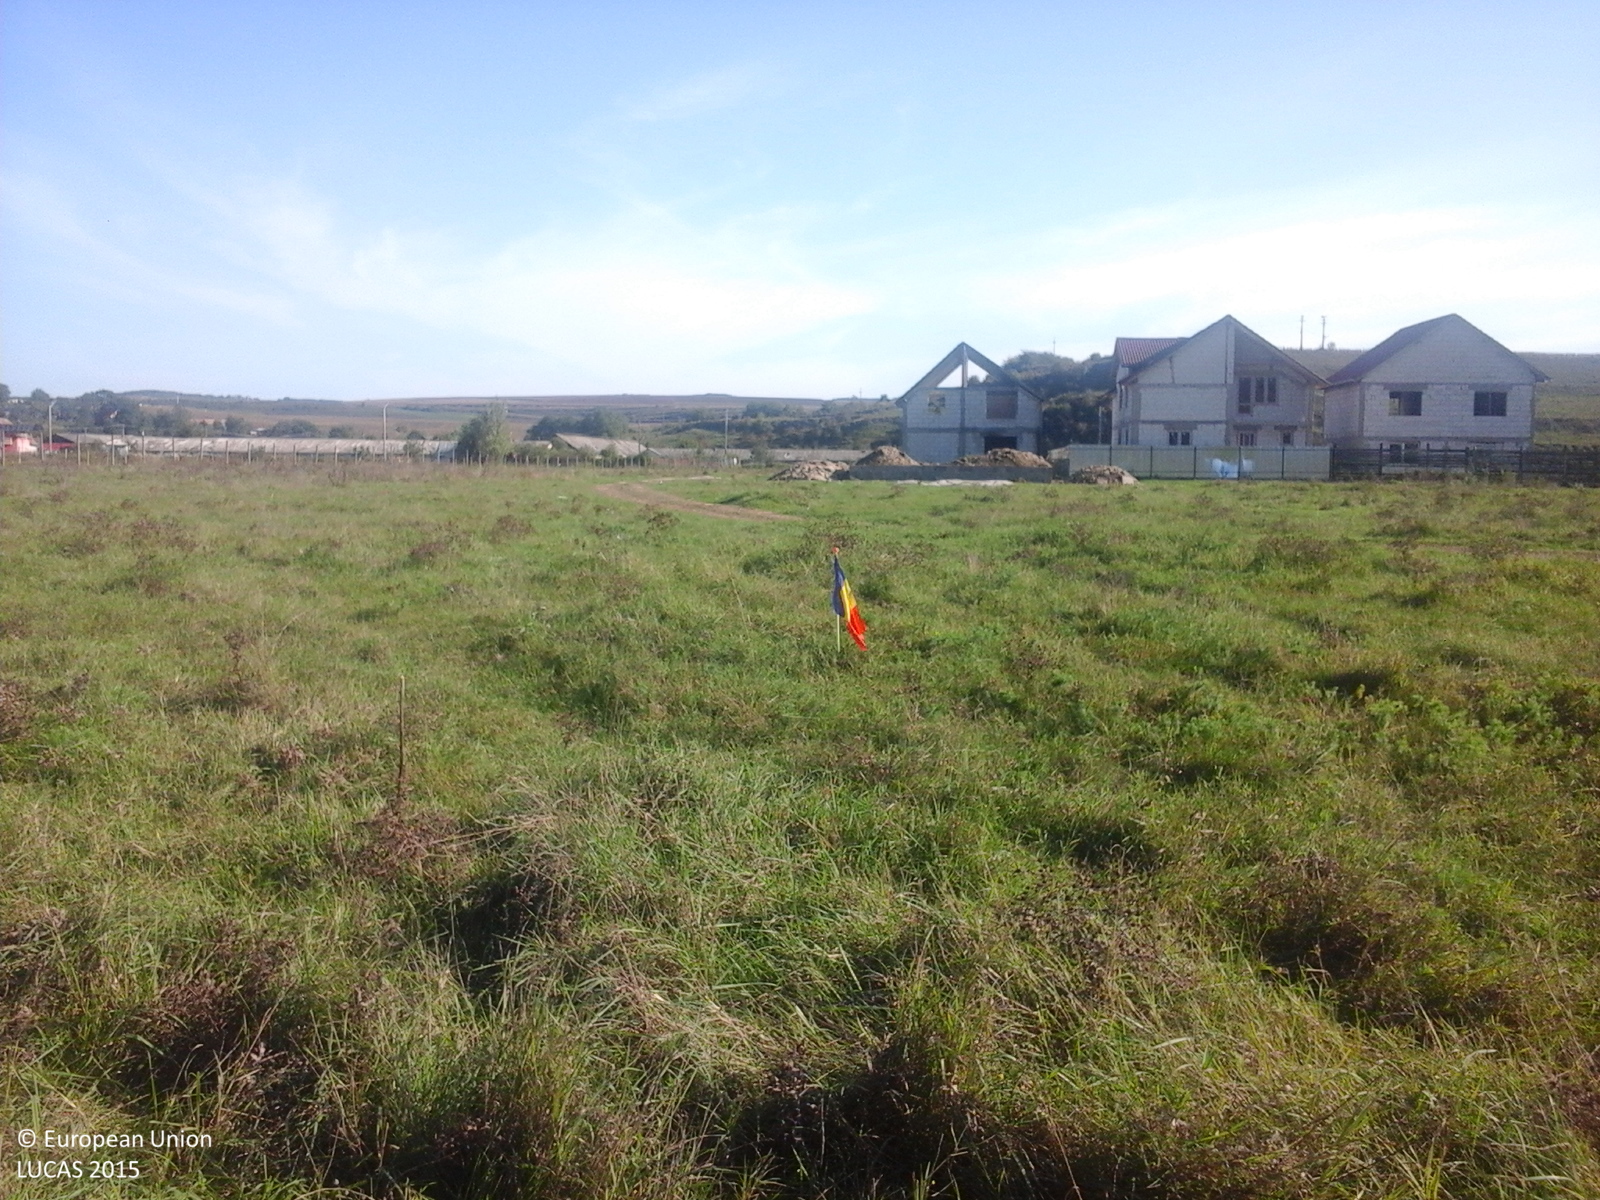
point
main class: Grassland
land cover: Grassland without tree/shrub cover
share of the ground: > 75 %
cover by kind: herbaceous plants 100 %
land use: Agriculture (excluding fallow land and kitchen gardens)
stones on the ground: < 10 %
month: October
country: RO
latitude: 46.1699
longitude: 23.8926
